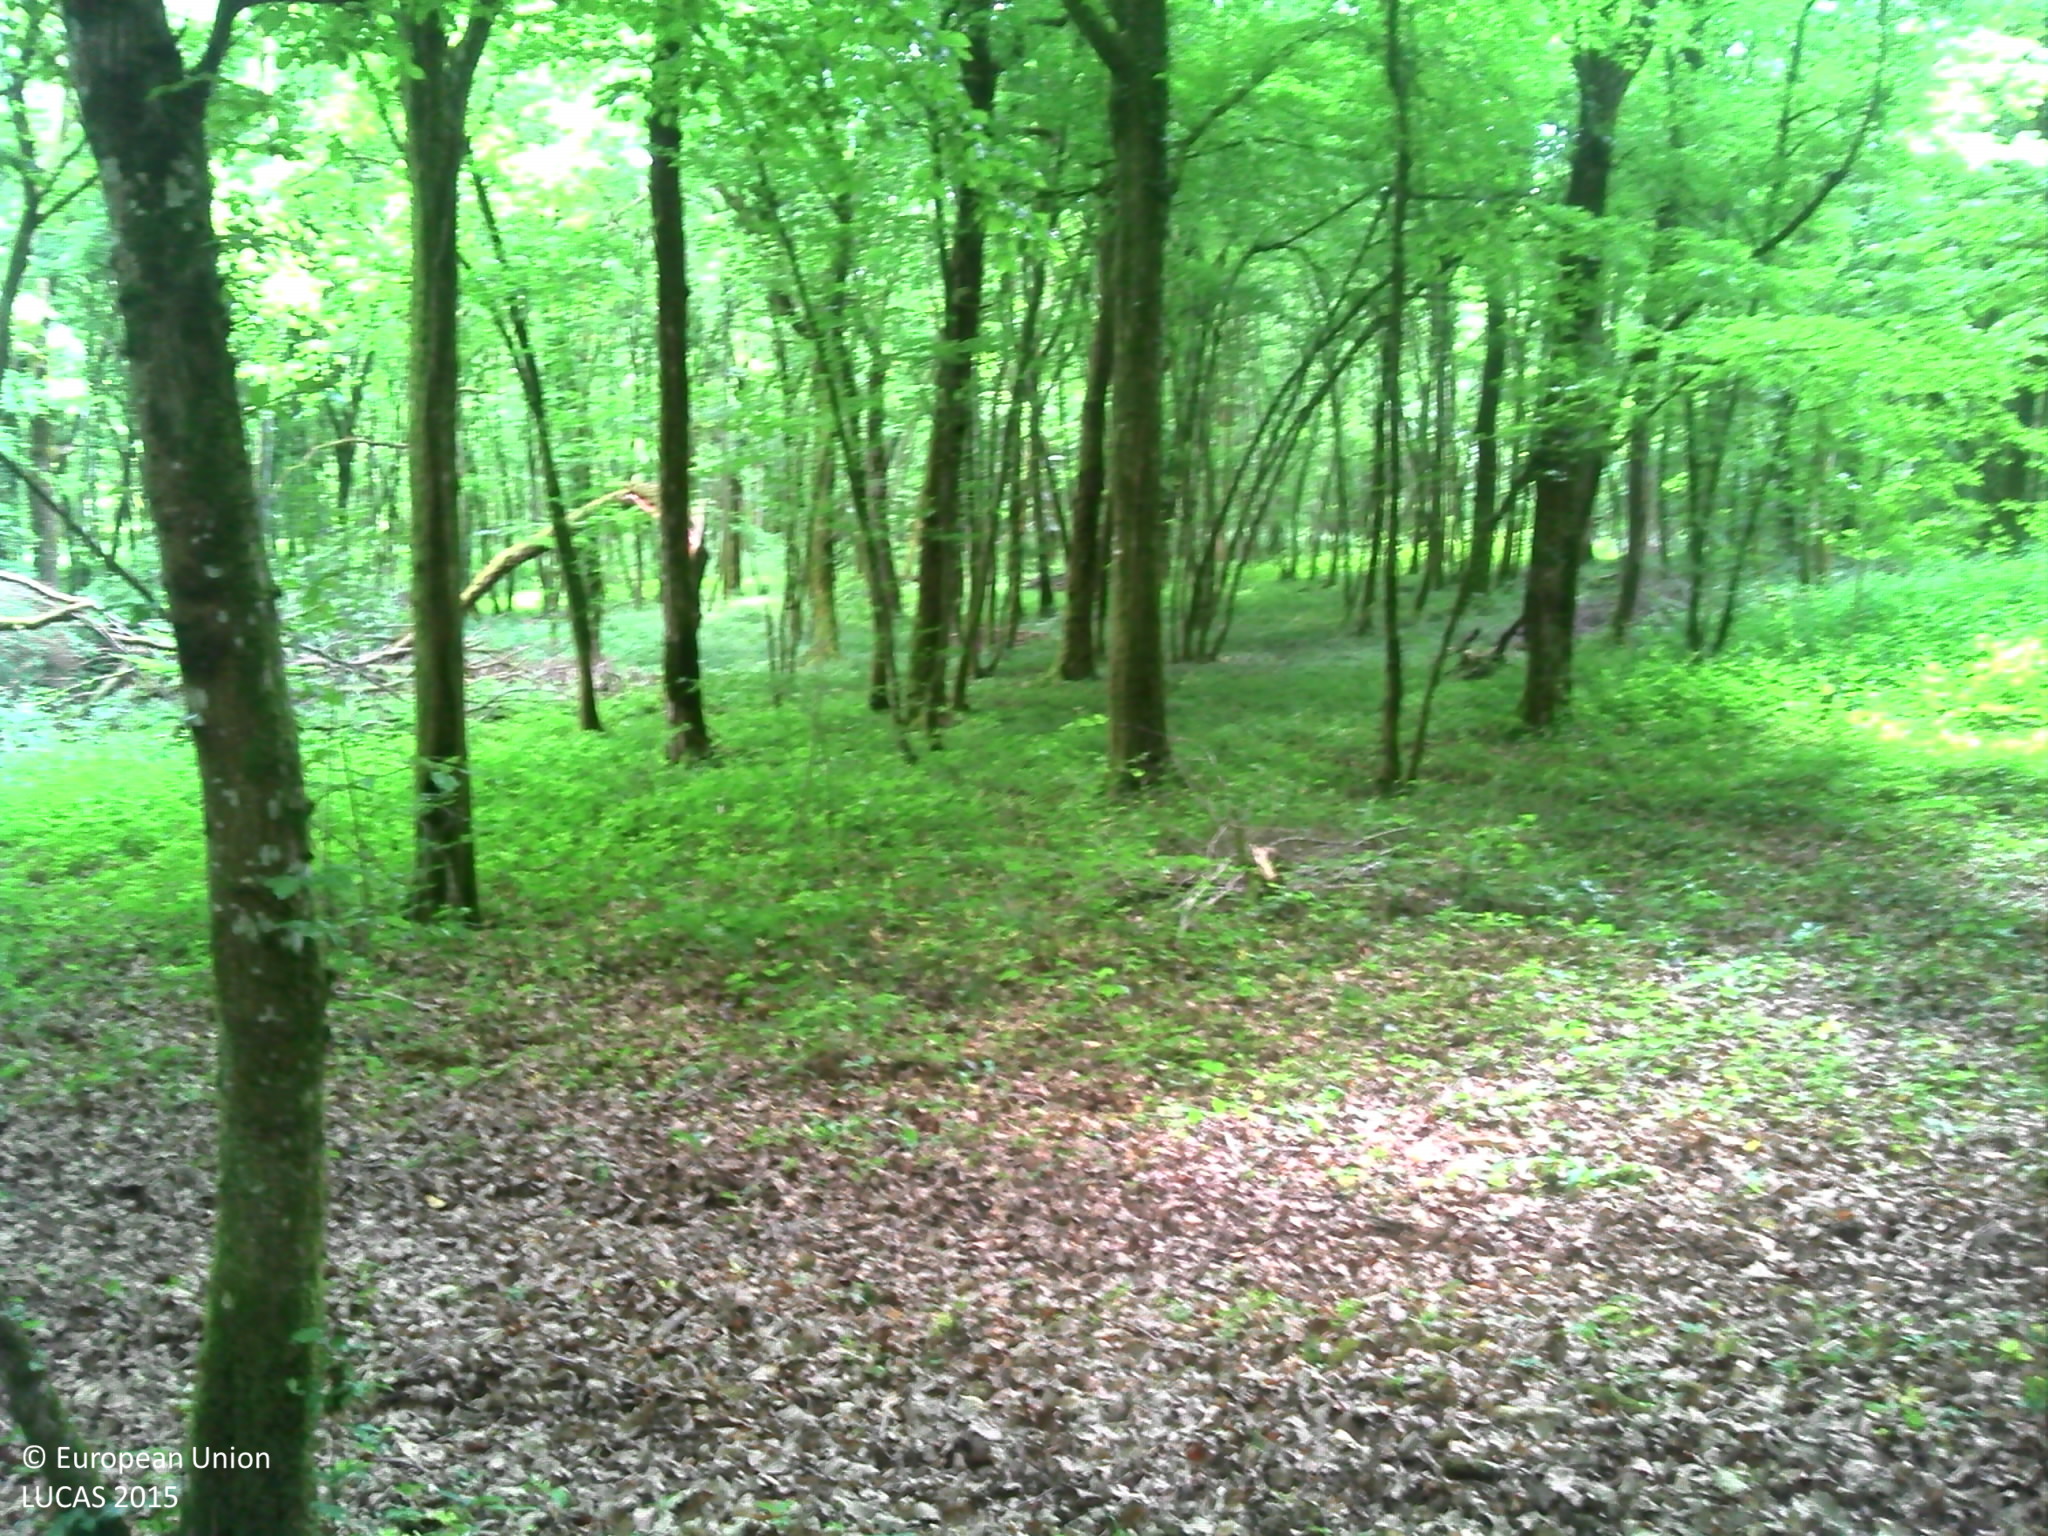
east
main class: Woodland
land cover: Broadleaved woodland
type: beech forest
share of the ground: > 75 %
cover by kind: broadleaved forest trees 95 %, herbaceous plants 5 %
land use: Forestry
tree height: > 5 m
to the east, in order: Broadleaved woodland; Tracks; Broadleaved woodland; Tracks; Broadleaved woodland
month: May
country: FR
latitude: 47.6412
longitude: 5.4082
